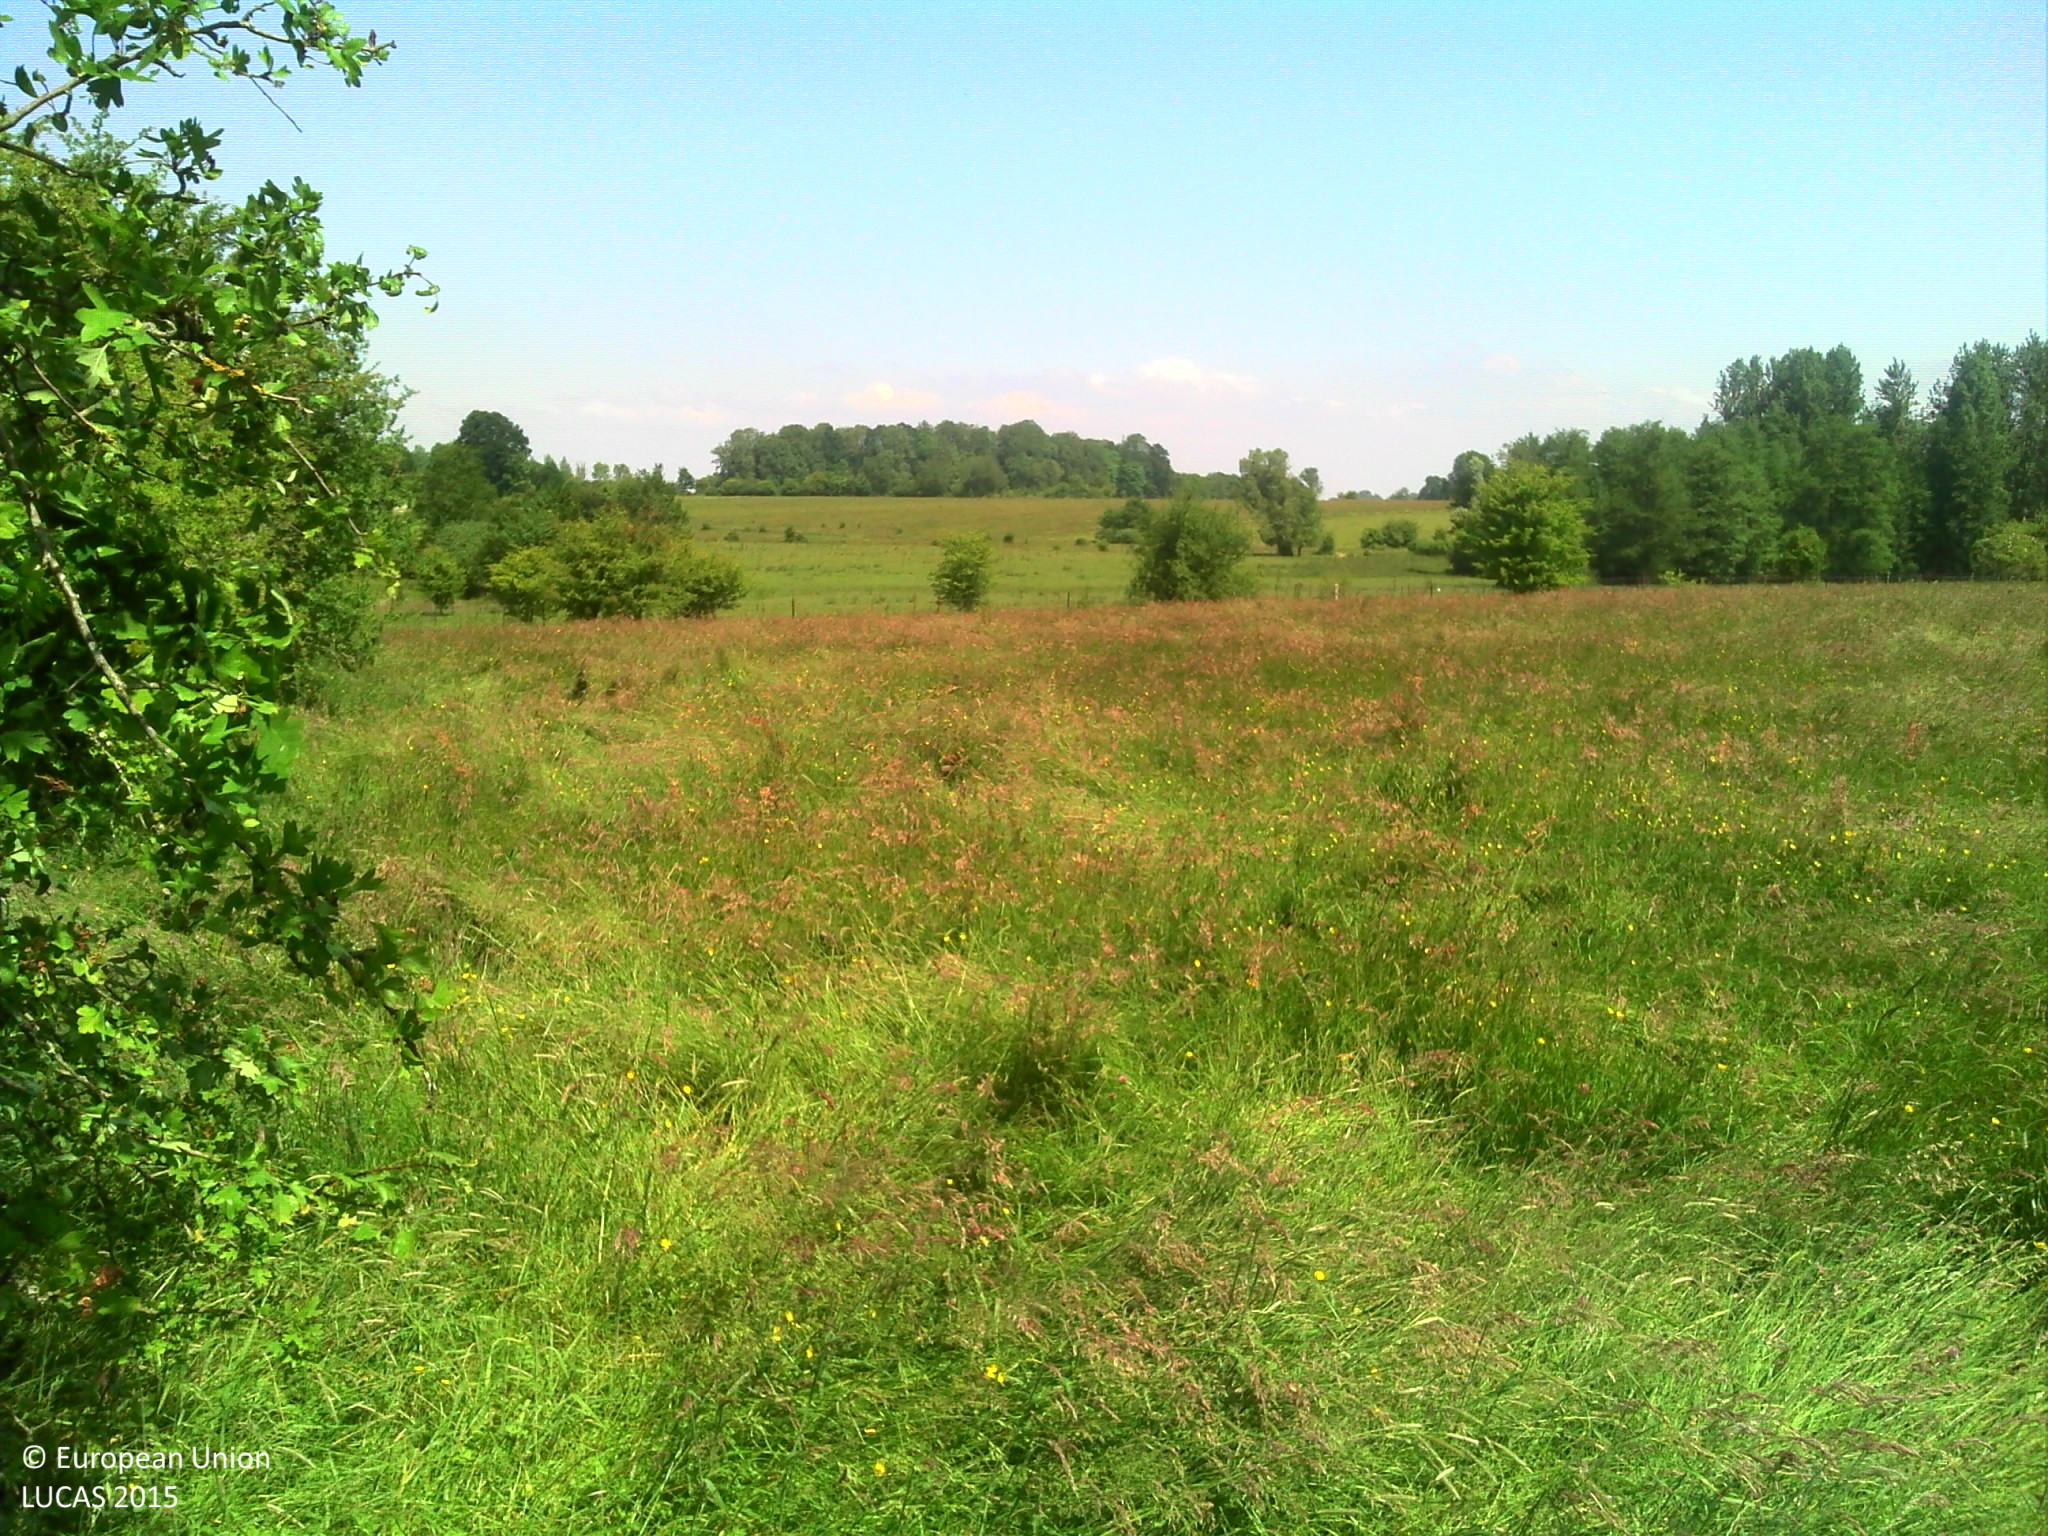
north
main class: Grassland
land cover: Grassland without tree/shrub cover
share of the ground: > 75 %
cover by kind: herbaceous plants 100 %
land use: Agriculture (excluding fallow land and kitchen gardens)
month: June
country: FR
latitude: 49.8159
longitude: 4.1161
